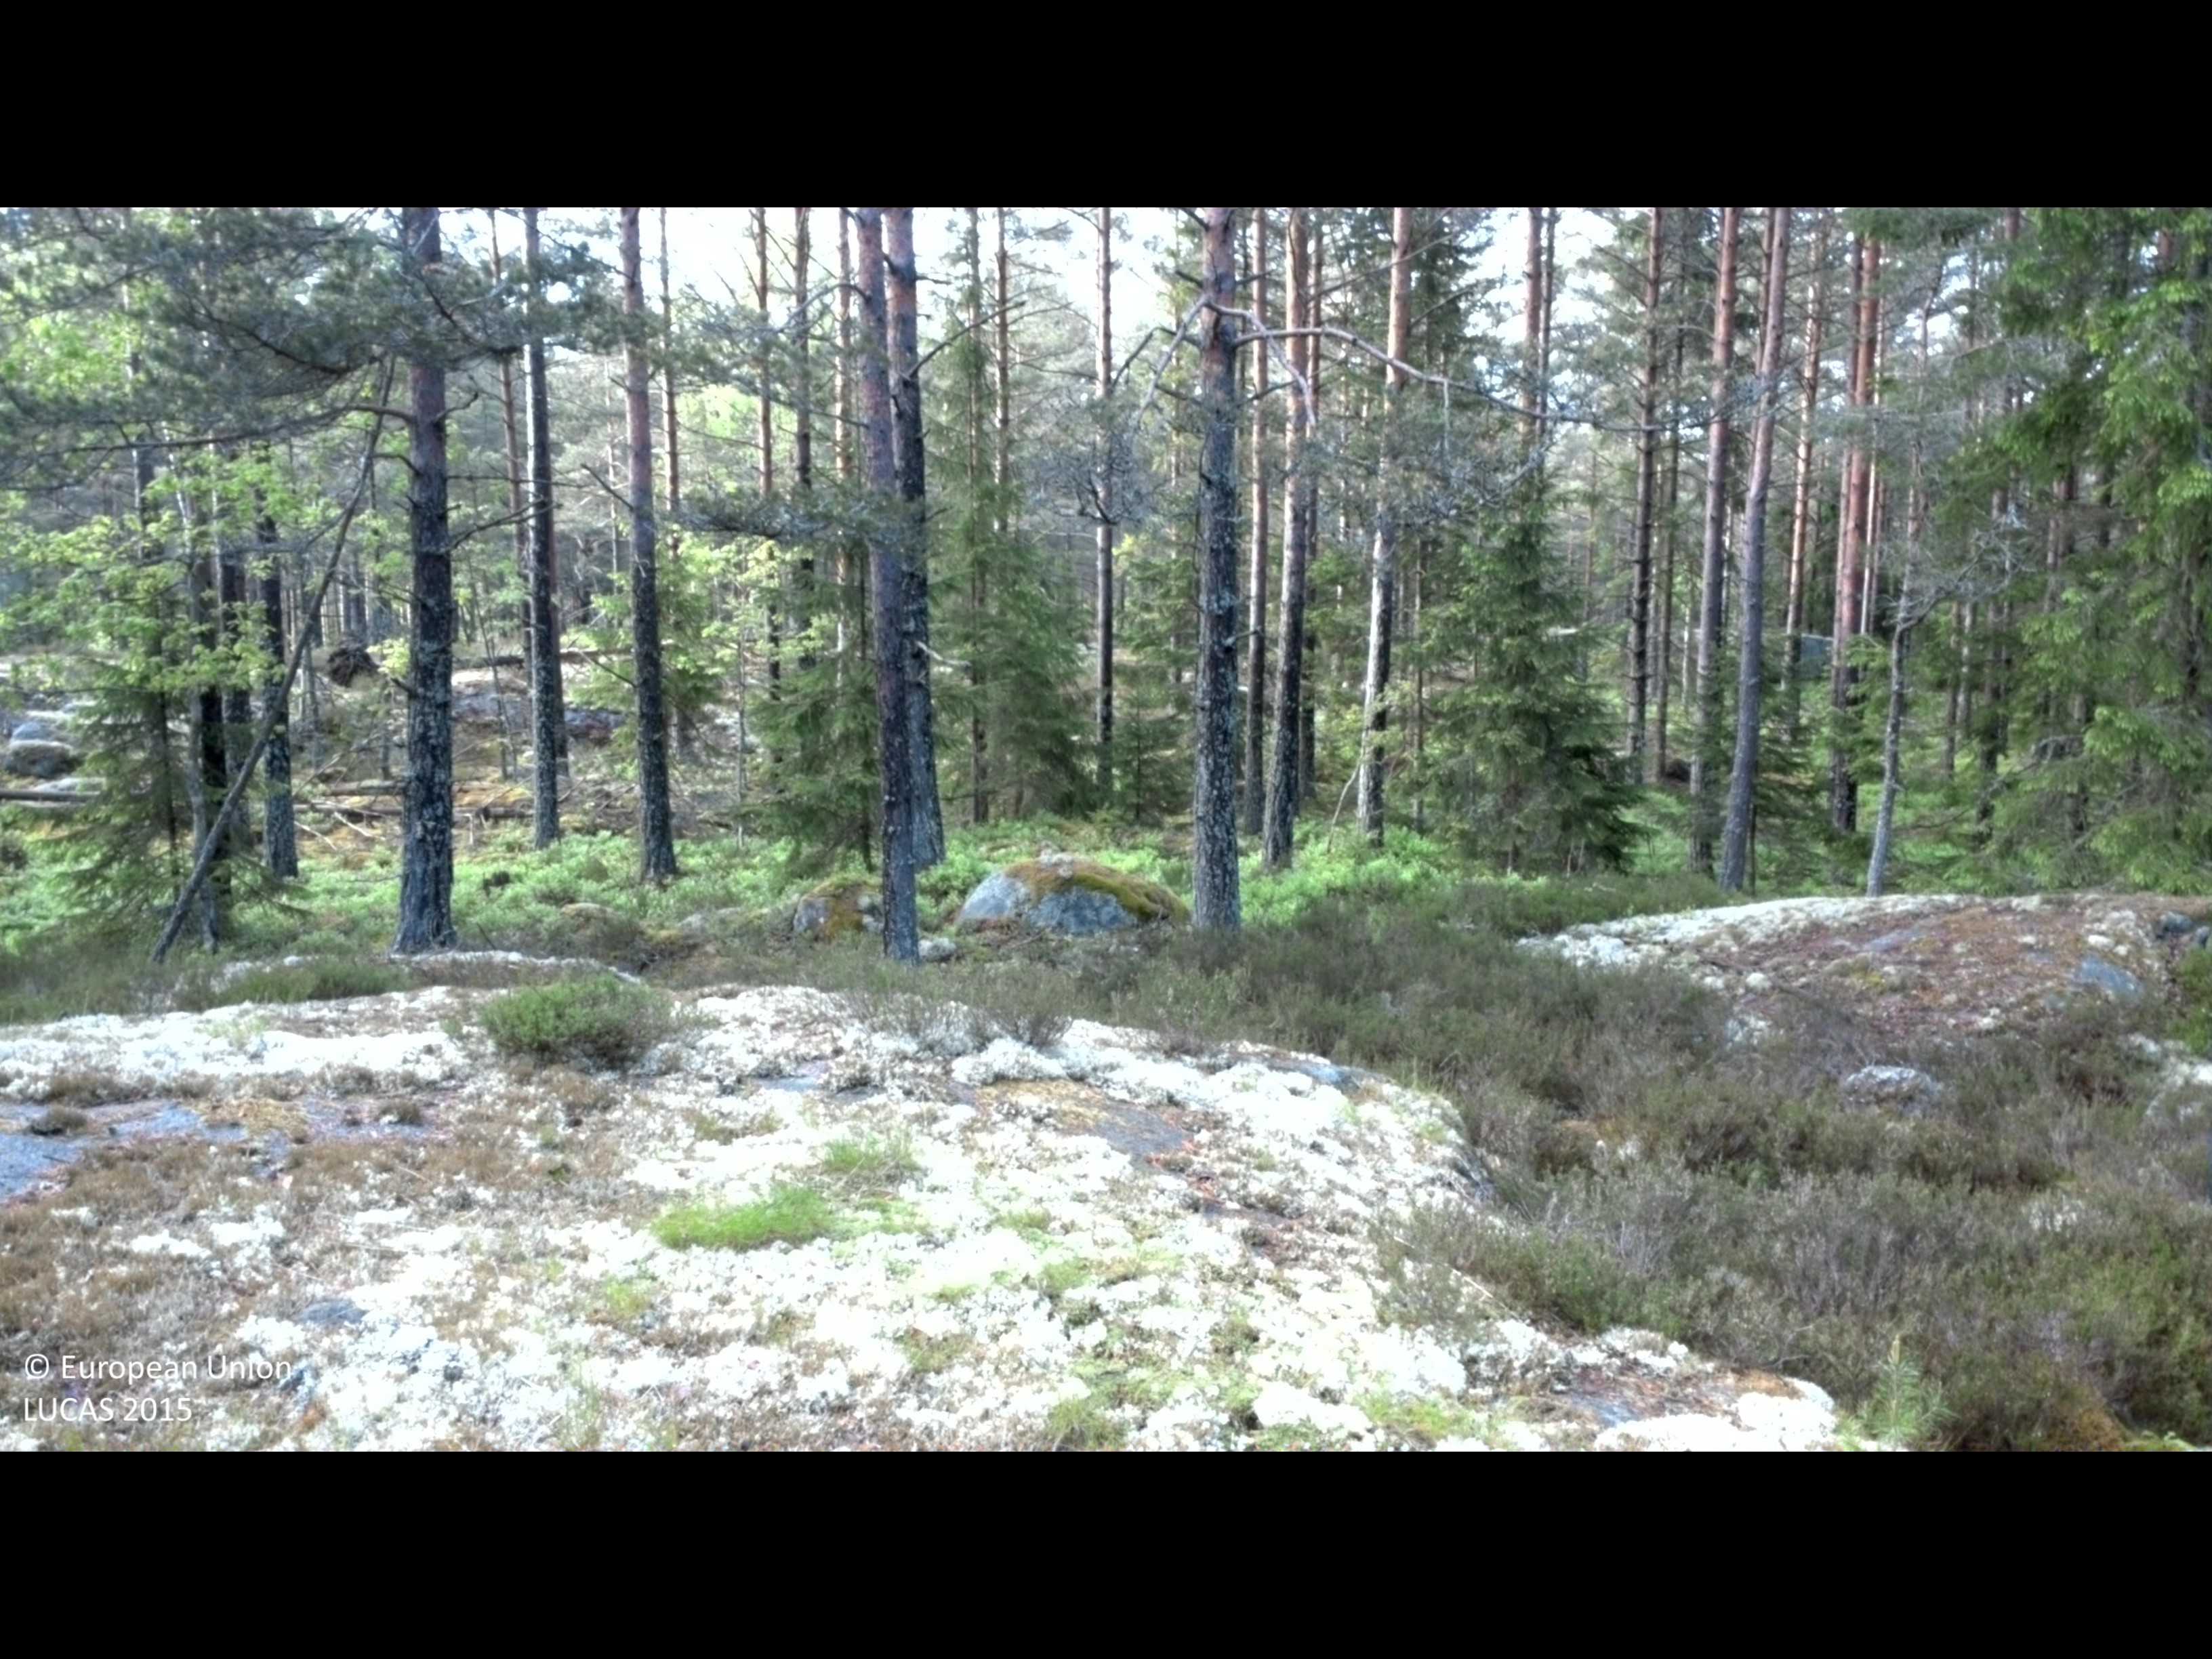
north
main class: Woodland
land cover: Pine dominated coniferous woodland
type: boreal forest
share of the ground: 25 - 50 %
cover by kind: coniferous forest trees 45 %, lichens and mosses 25 %, shrubs 15 %, broadleaved forest trees 5 %, herbaceous plants 5 %, consolidated bare surface 5 %
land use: Forestry
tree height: > 5 m
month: May
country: SE
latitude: 57.4299
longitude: 16.5116
